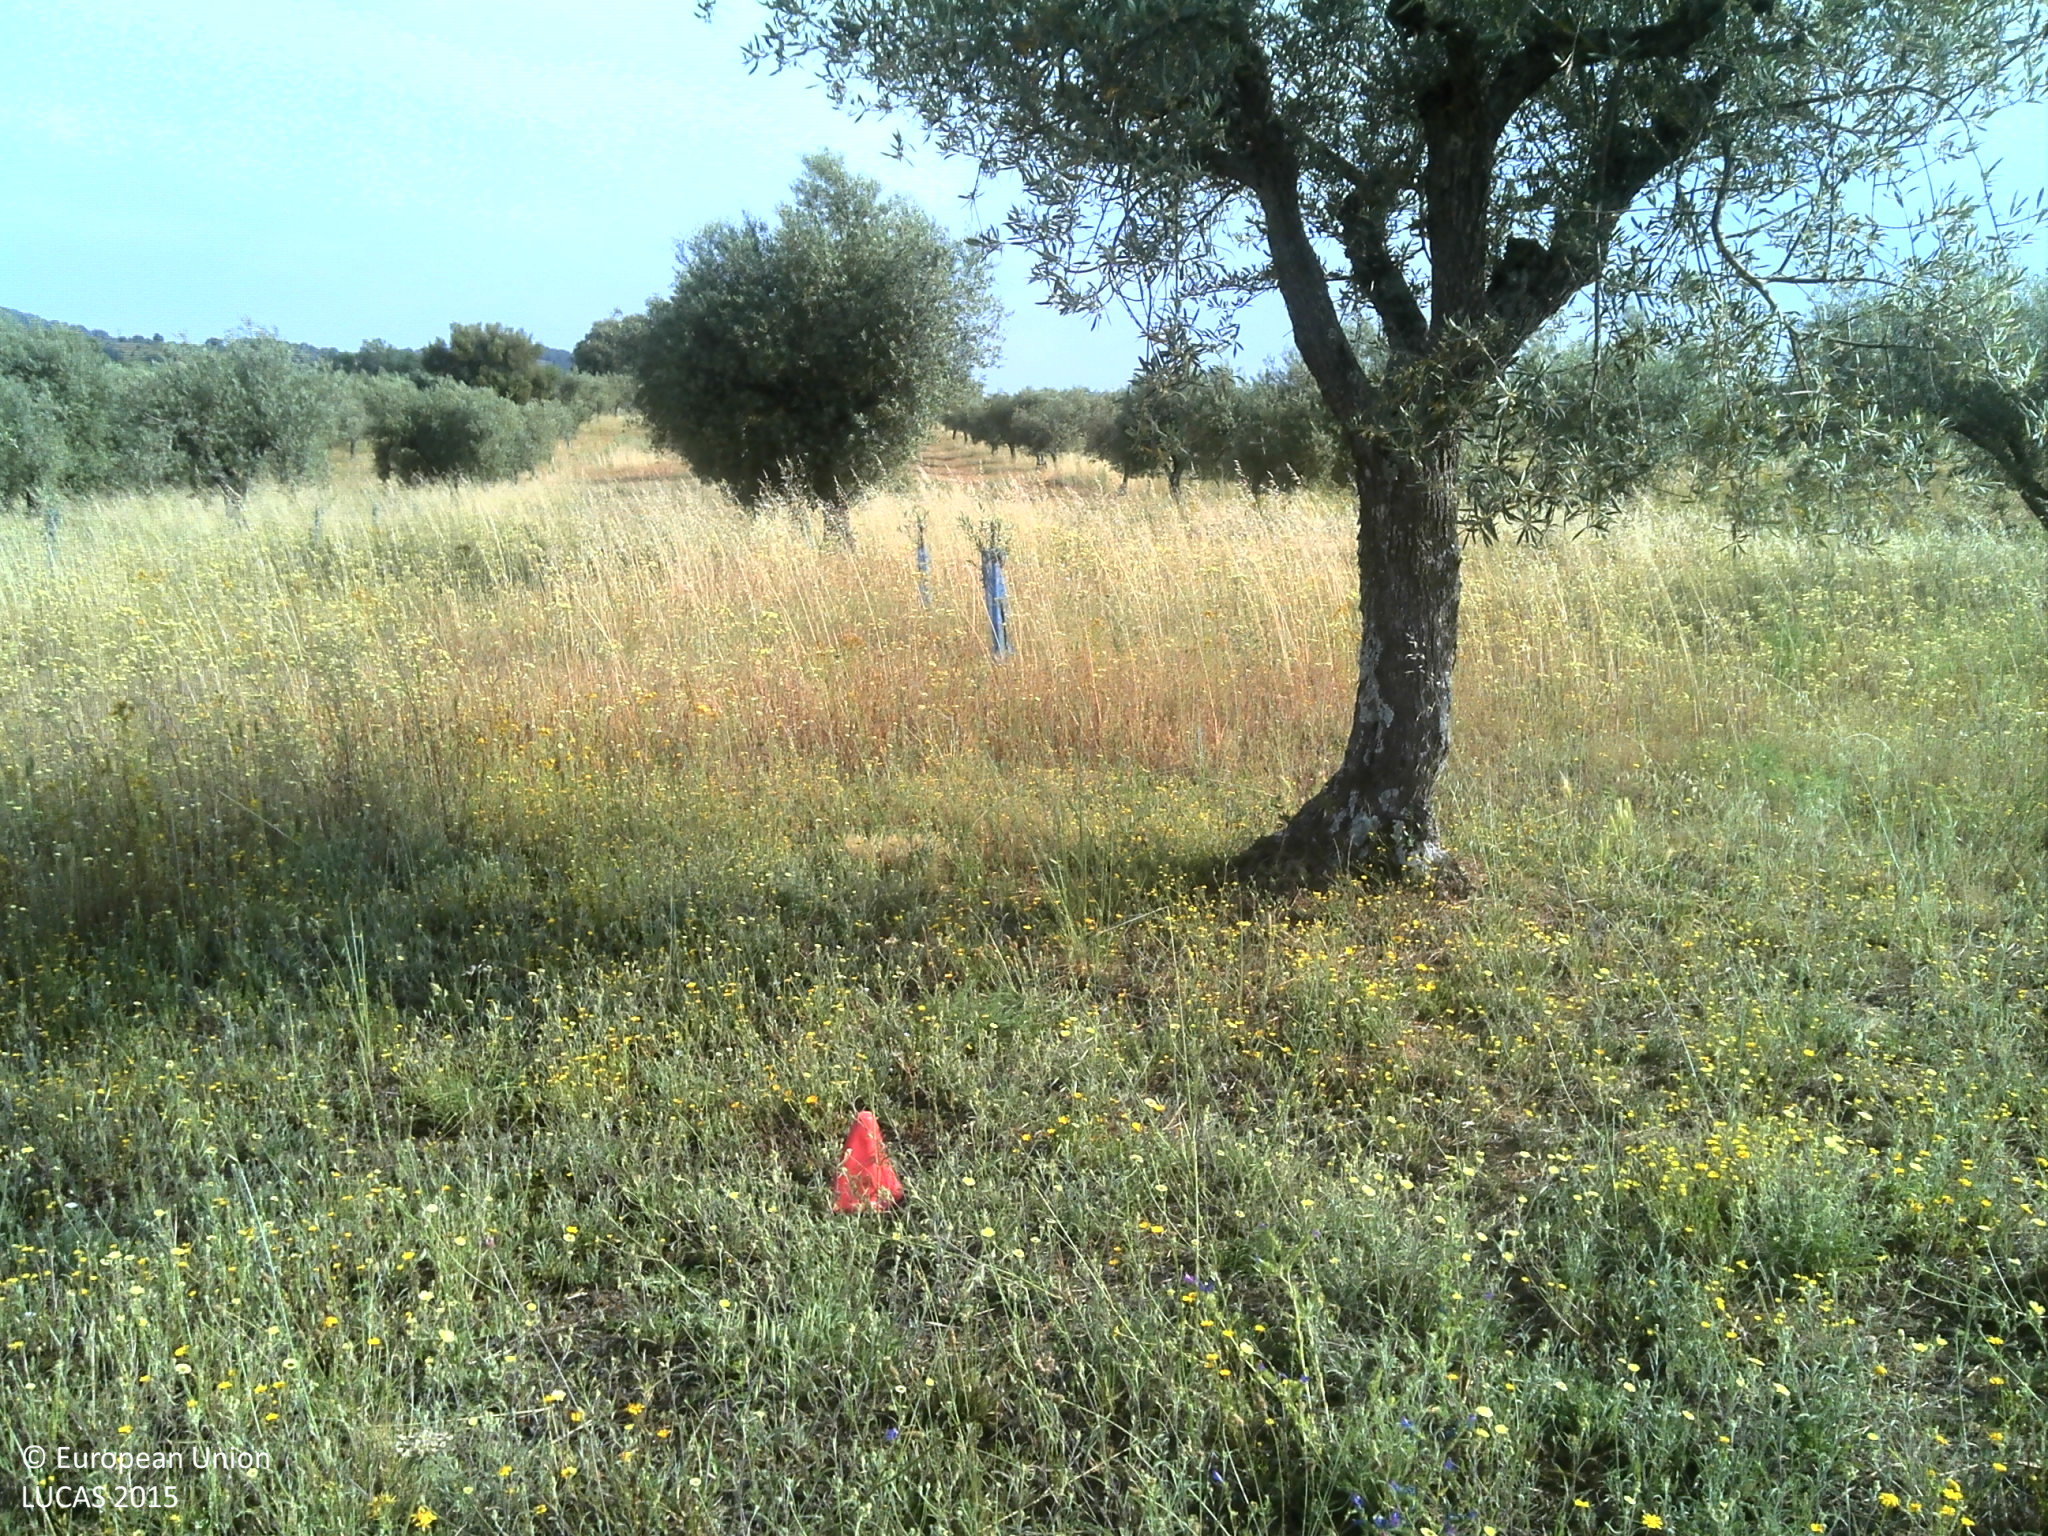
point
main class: Cropland
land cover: Olive groves
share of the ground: < 10 %
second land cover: Spontaneously vegetated surfaces
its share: 50 - 75 %
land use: Agriculture (excluding fallow land and kitchen gardens)
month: June
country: PT
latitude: 41.5219
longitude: -6.9751
